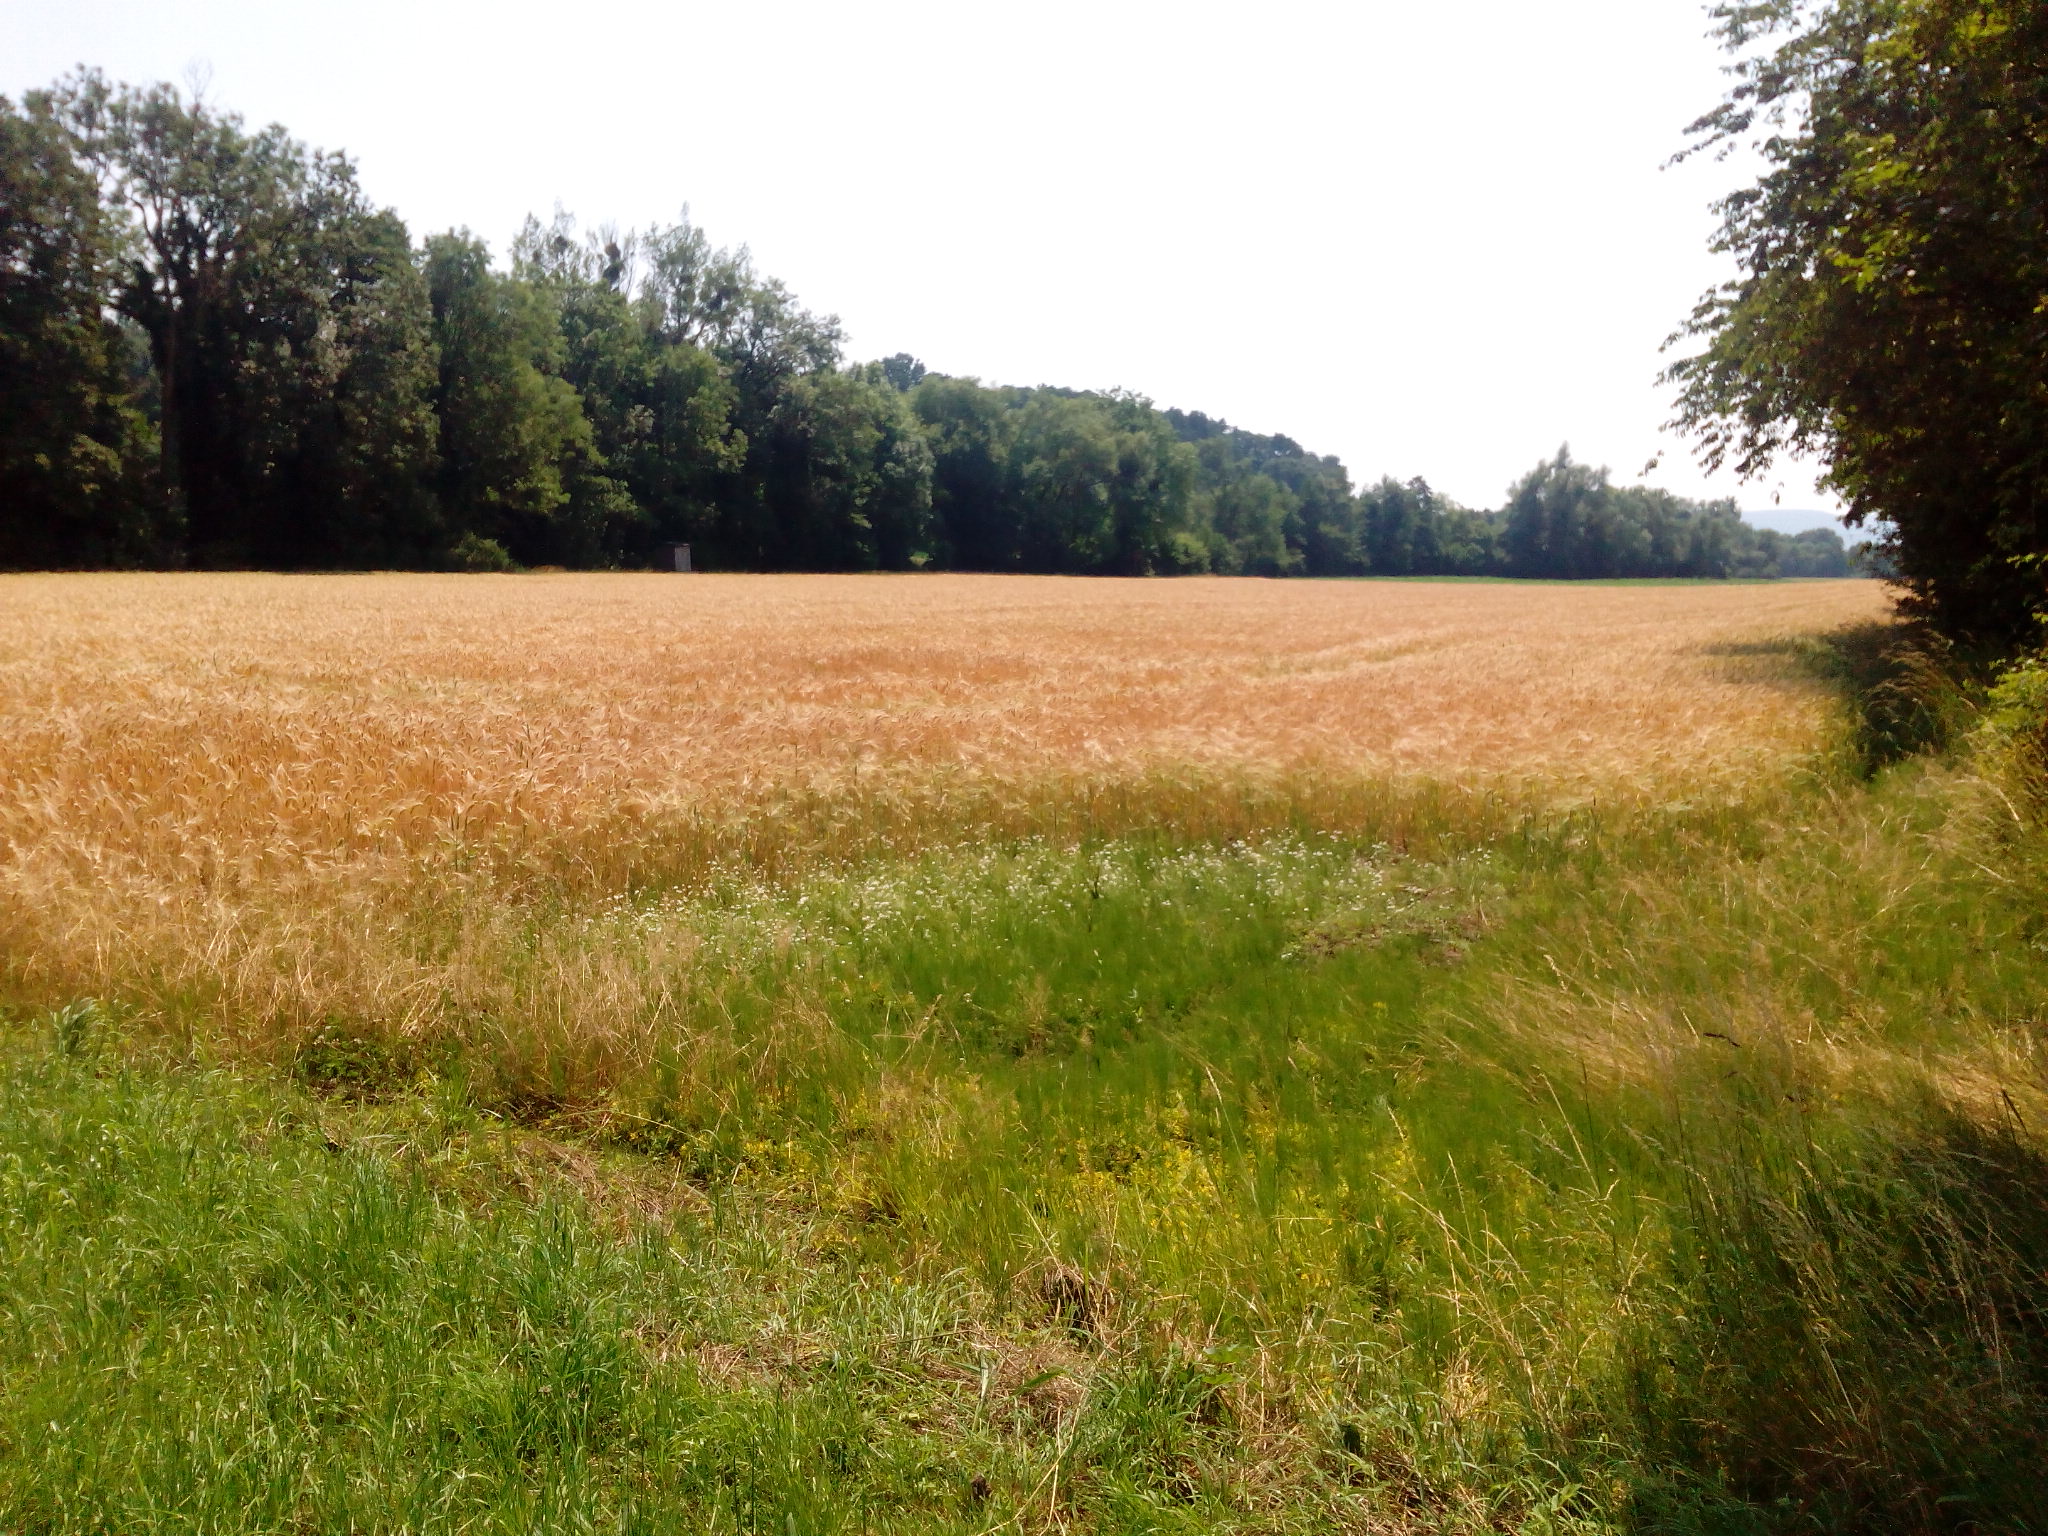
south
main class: Grassland
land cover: Grassland without tree/shrub cover
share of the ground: > 75 %
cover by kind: herbaceous plants 100 %
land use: Agriculture (excluding fallow land and kitchen gardens)
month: July
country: DE
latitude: 52.1776
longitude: 9.2837
